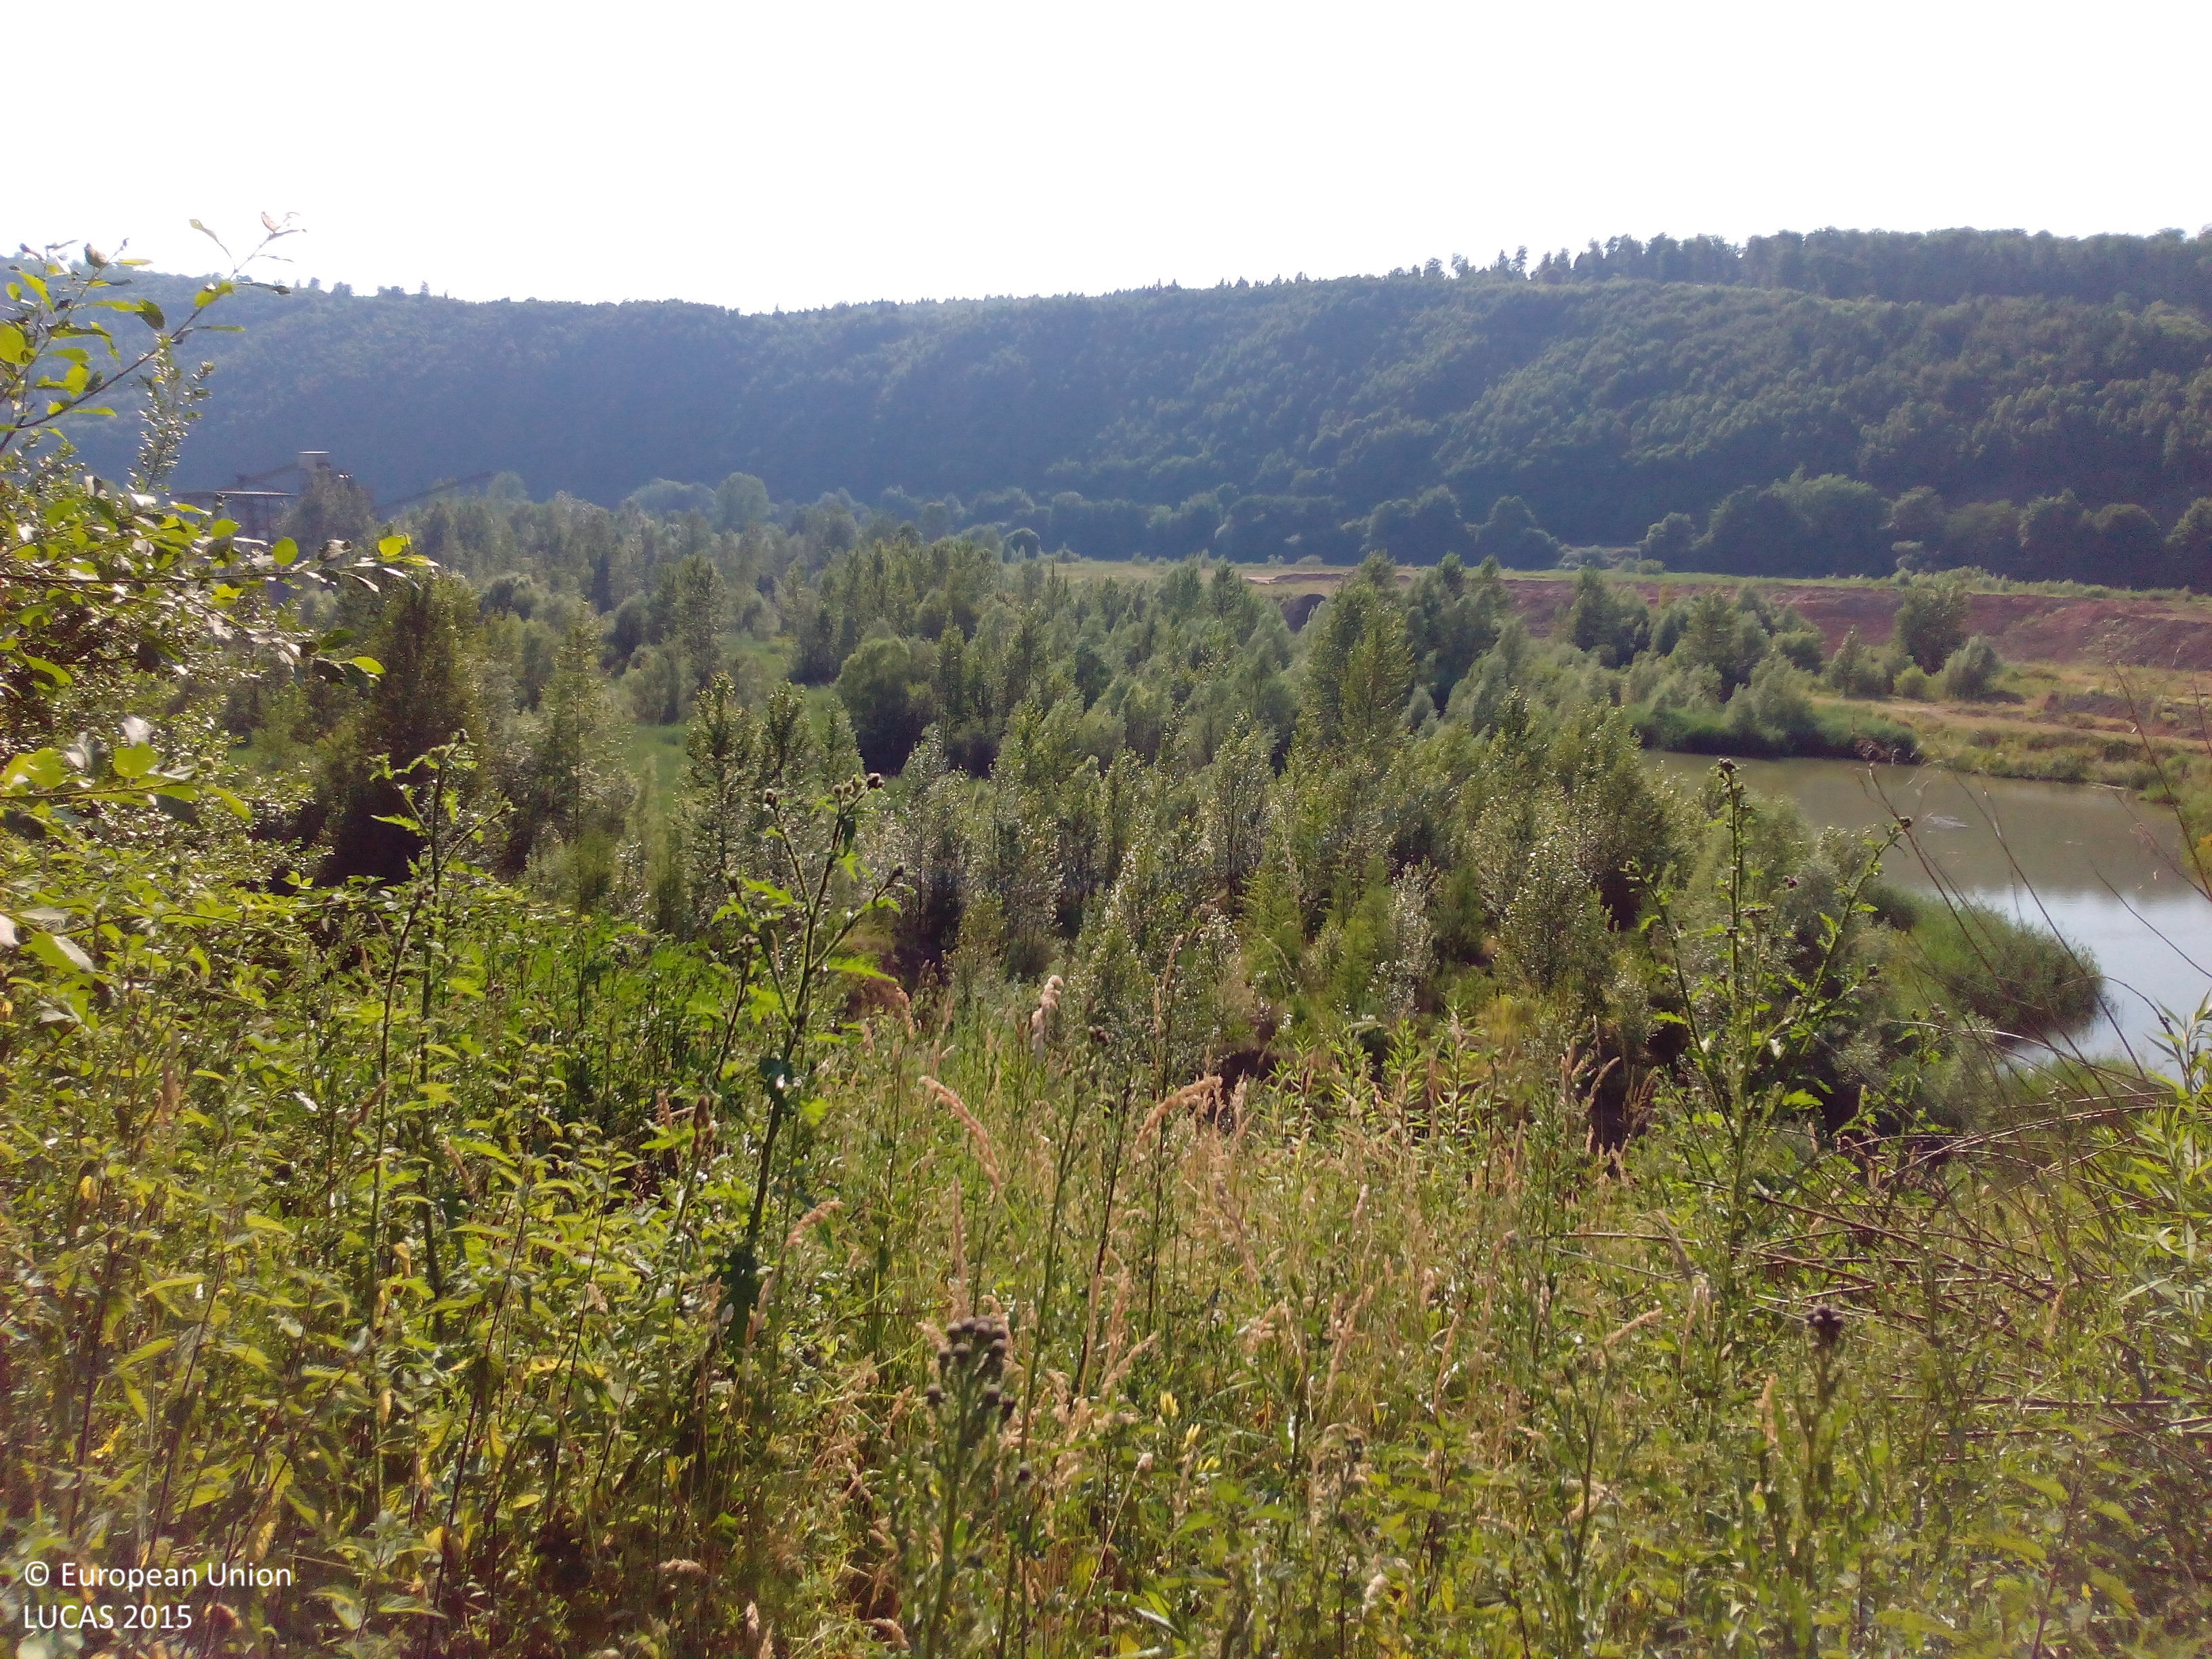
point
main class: Woodland
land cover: Broadleaved woodland
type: non-riverine alder, birch or aspen forest
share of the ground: > 75 %
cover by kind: broadleaved forest trees 75 %, herbaceous plants 15 %, shrubs 10 %
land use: Mining and quarrying
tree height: > 5 m
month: July
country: DE
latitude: 51.4602
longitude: 9.6403
